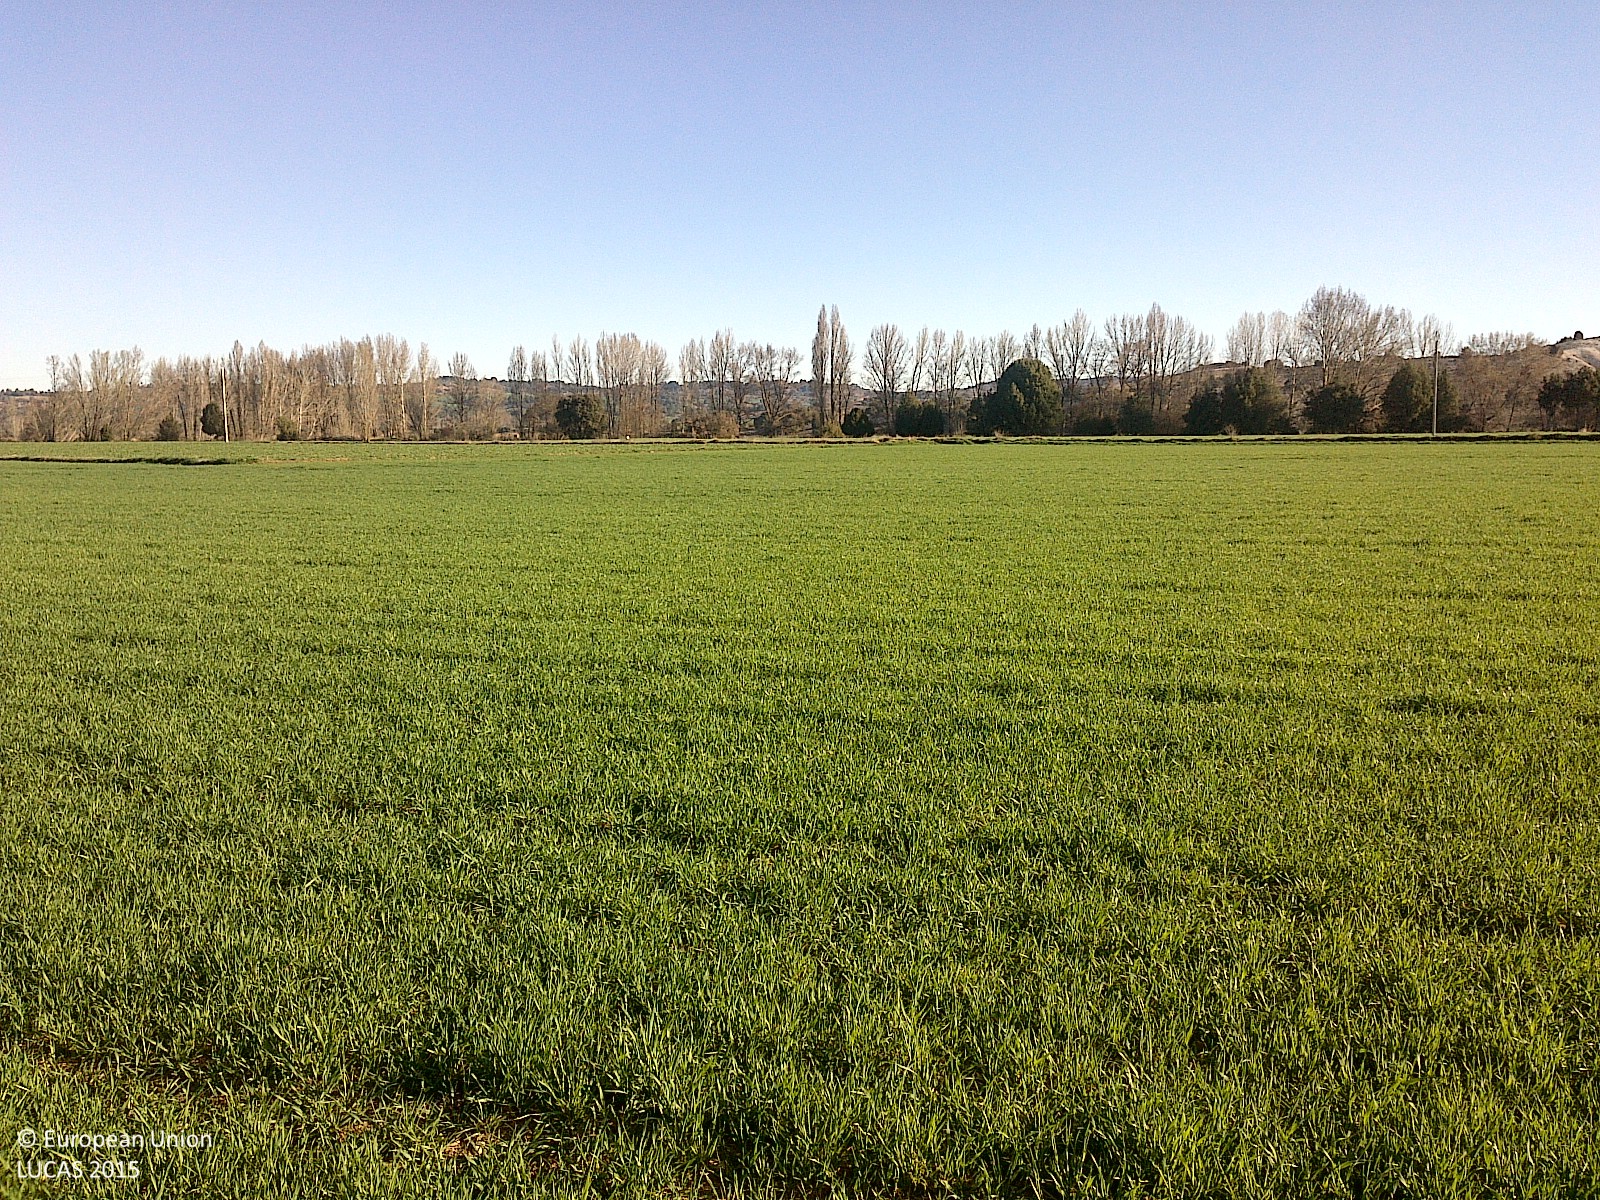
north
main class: Cropland
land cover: Common wheat
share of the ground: > 75 %
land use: Agriculture (excluding fallow land and kitchen gardens)
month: April
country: ES
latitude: 41.6349
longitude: -3.5067
